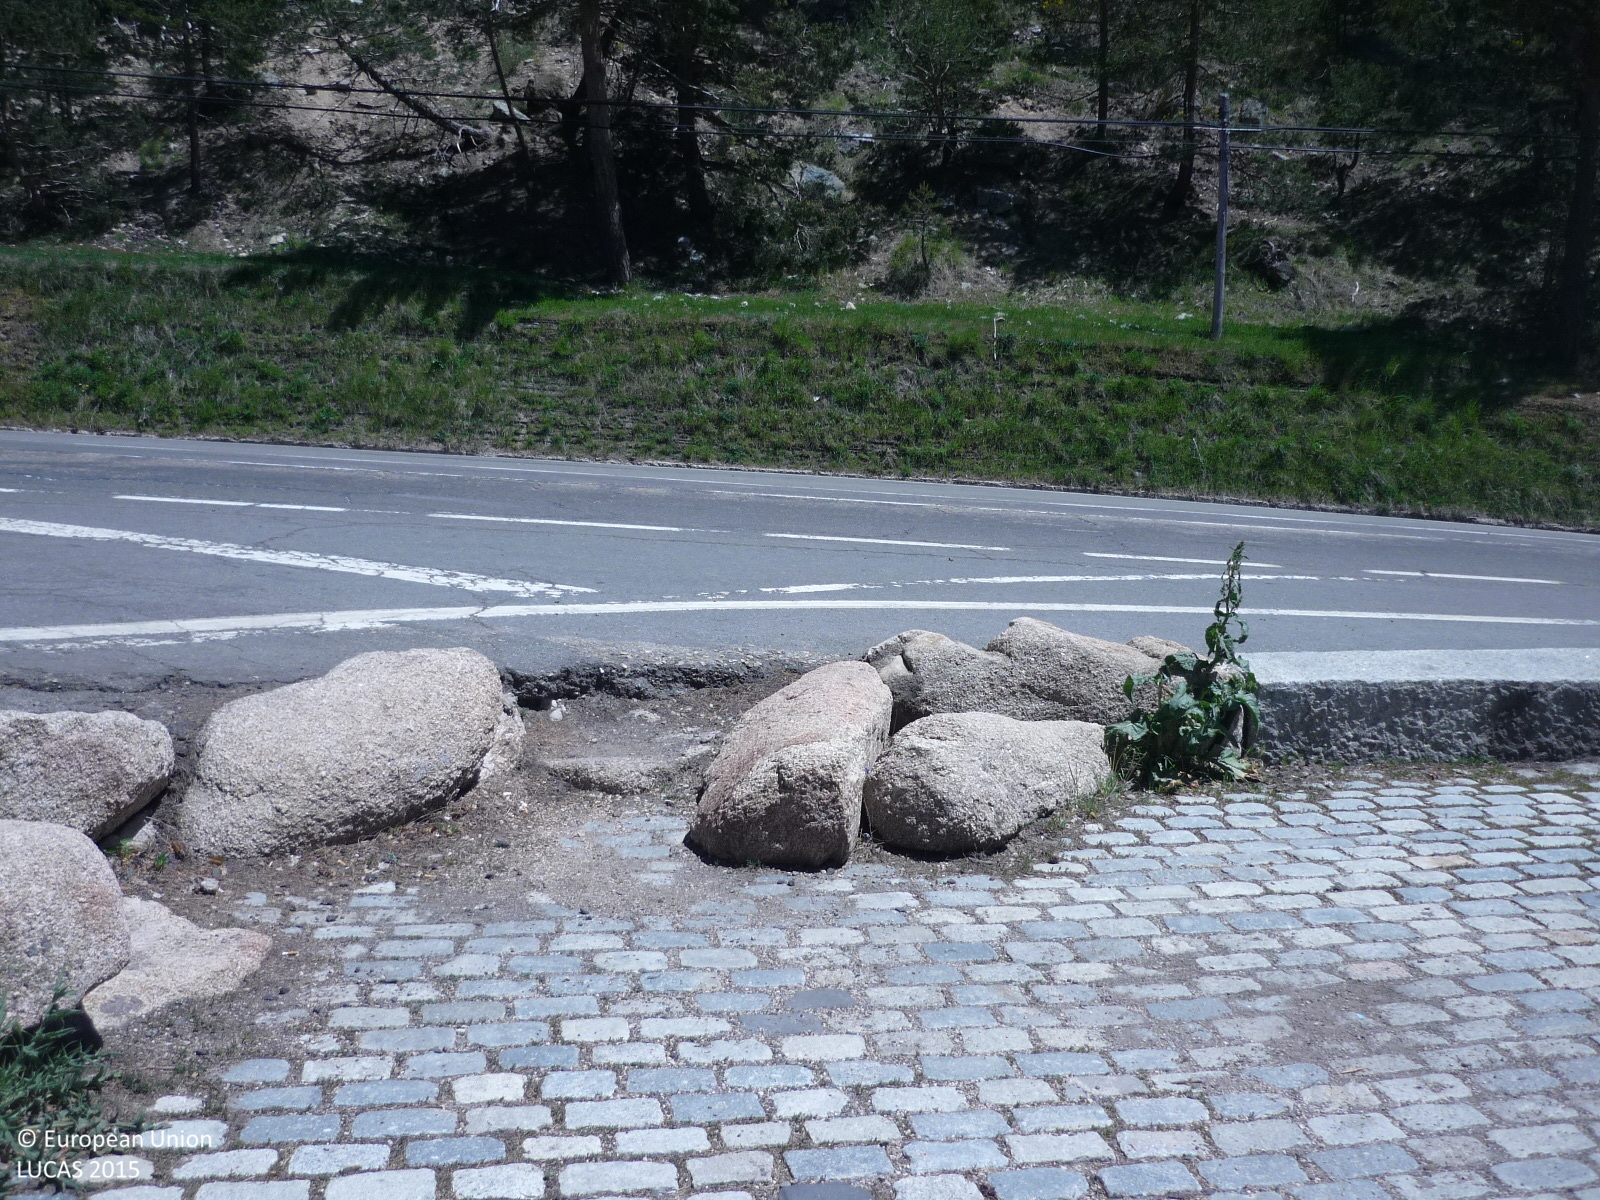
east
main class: Woodland
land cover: Pine dominated coniferous woodland
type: coniferous forest of the mediterranean region
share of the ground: > 75 %
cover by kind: coniferous forest trees 85 %, shrubs 10 %, herbaceous plants 5 %
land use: Forestry
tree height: > 5 m
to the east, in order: Pine dominated coniferous woodland; Tracks; Pine dominated coniferous woodland
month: May
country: ES
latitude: 40.7768
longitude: -4.0161
